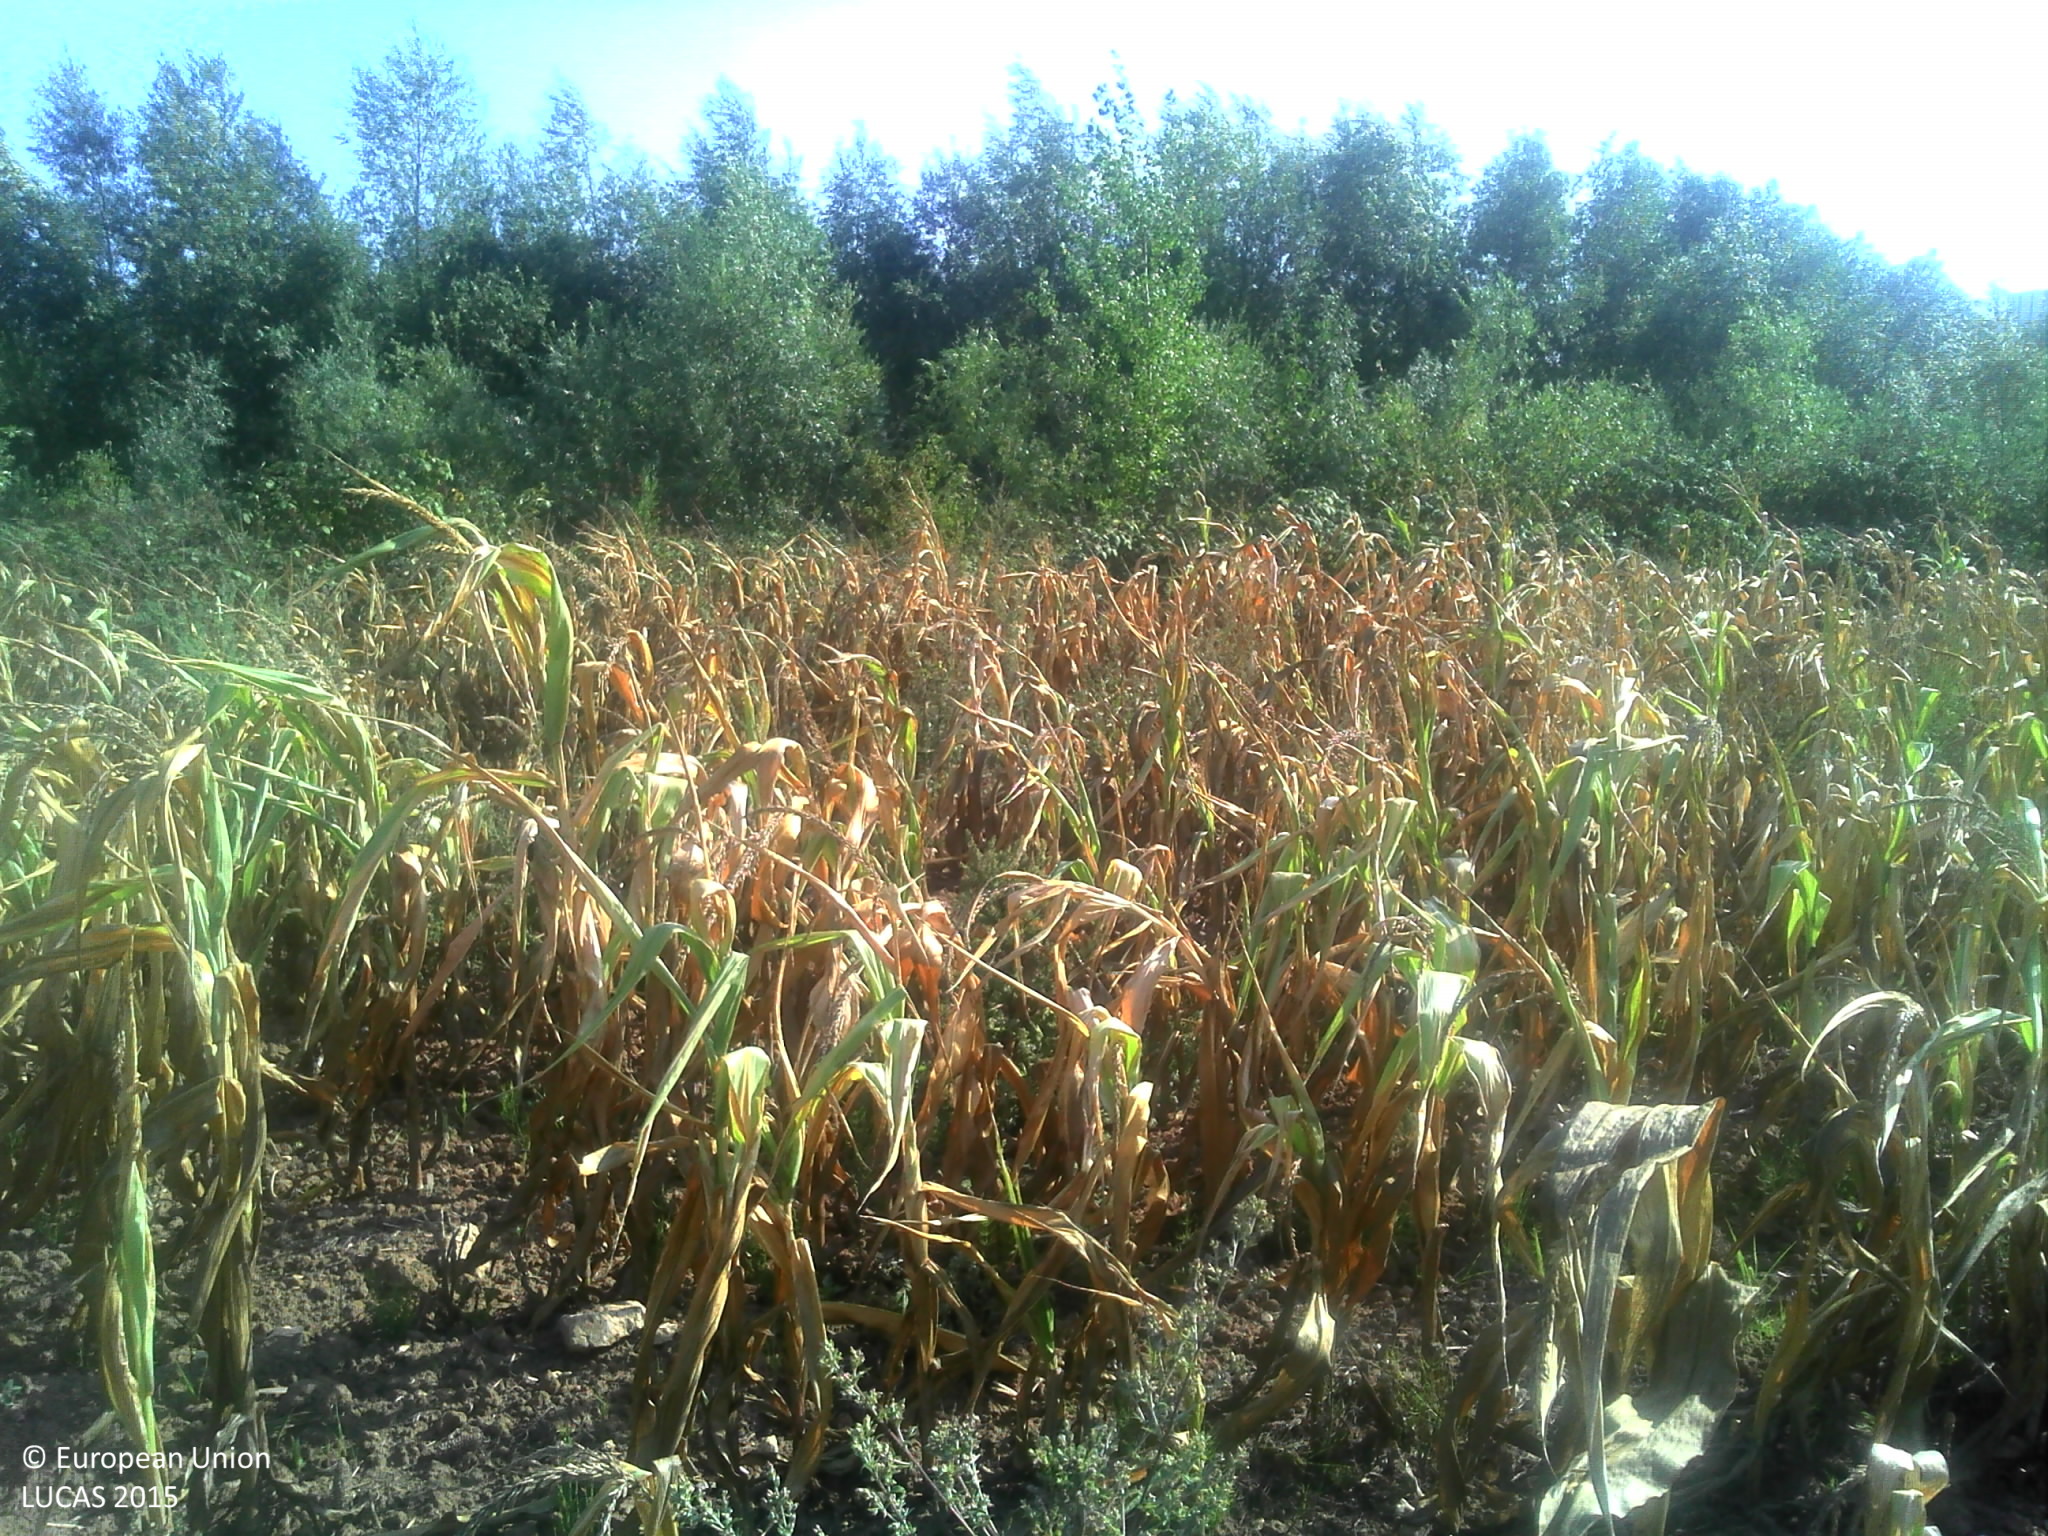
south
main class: Cropland
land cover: Maize
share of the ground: > 75 %
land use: Agriculture (excluding fallow land and kitchen gardens)
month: August
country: FR
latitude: 48.8746
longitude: 6.0866
